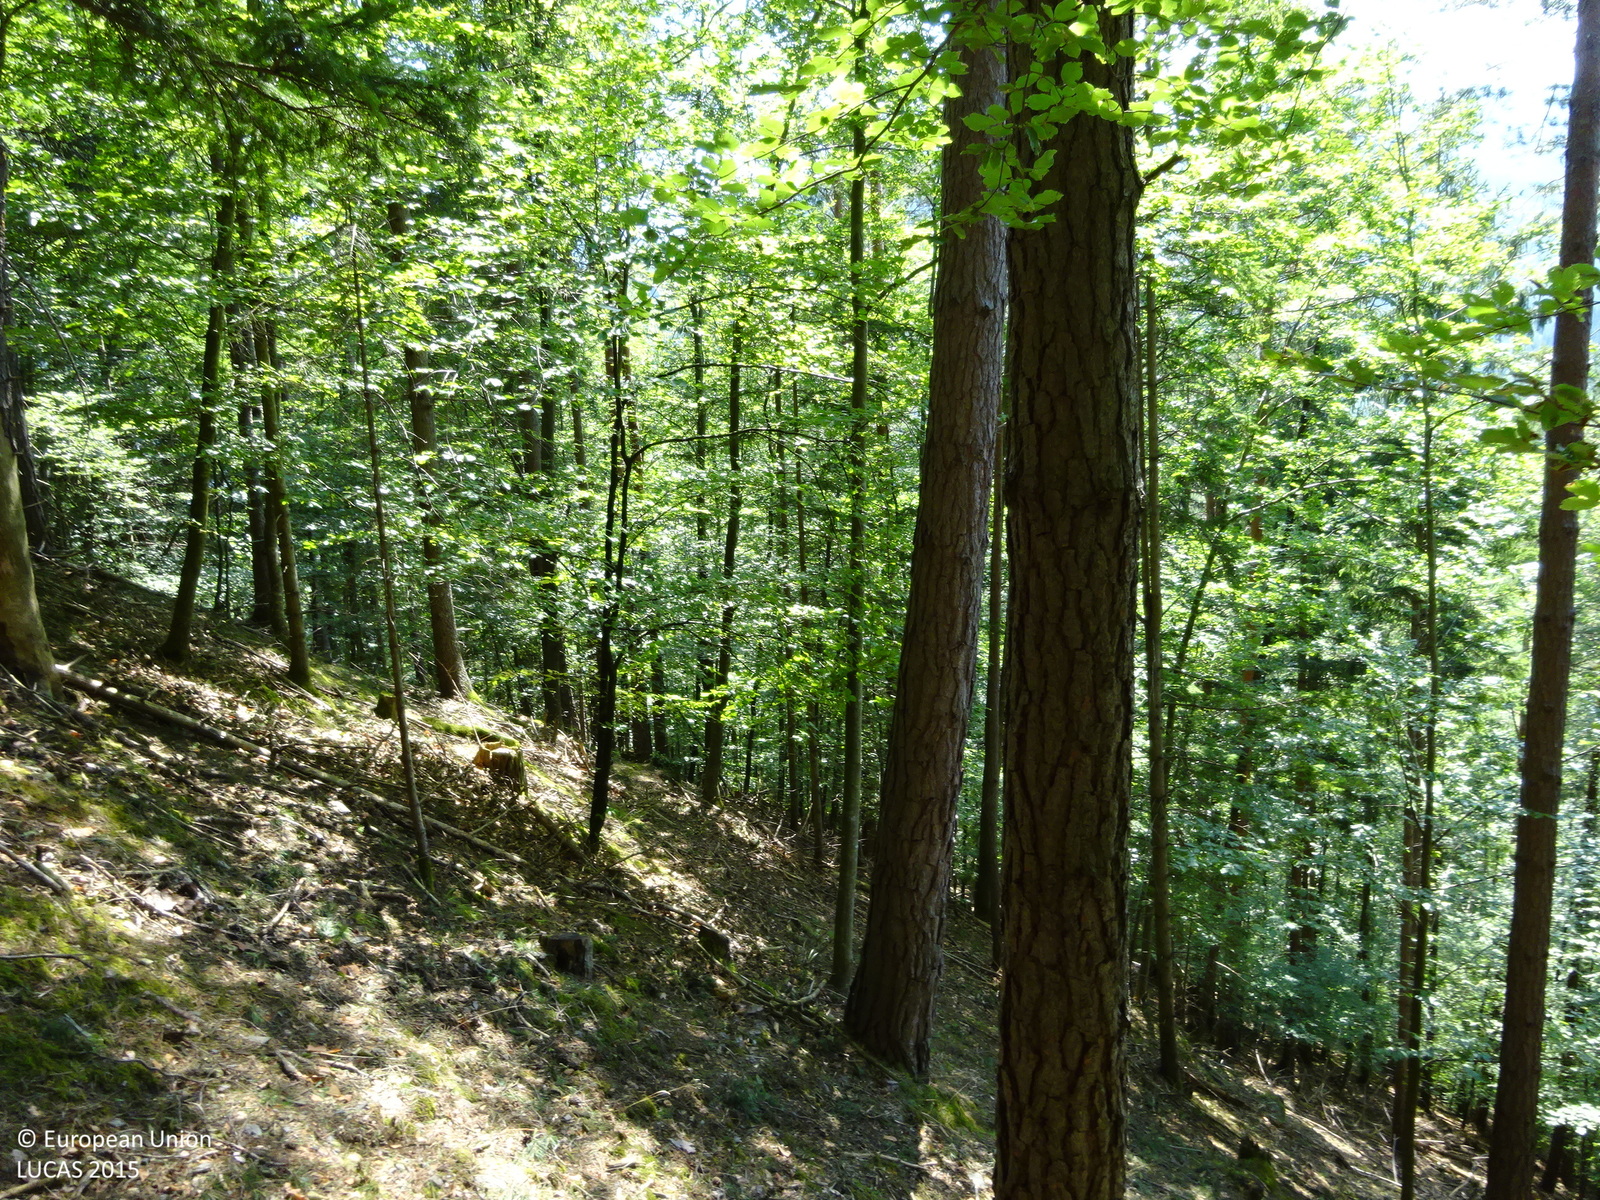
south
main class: Woodland
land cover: Pine dominated mixed woodland
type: hemiboreal forest and nemoral coniferous forest and mixed broadleaved-coniferous forest
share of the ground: > 75 %
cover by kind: coniferous forest trees 45 %, broadleaved forest trees 45 %, lichens and mosses 5 %, unconsolidated bare surface 5 %
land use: Forestry
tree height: > 5 m
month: July
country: AT
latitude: 47.2857
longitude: 15.2754
